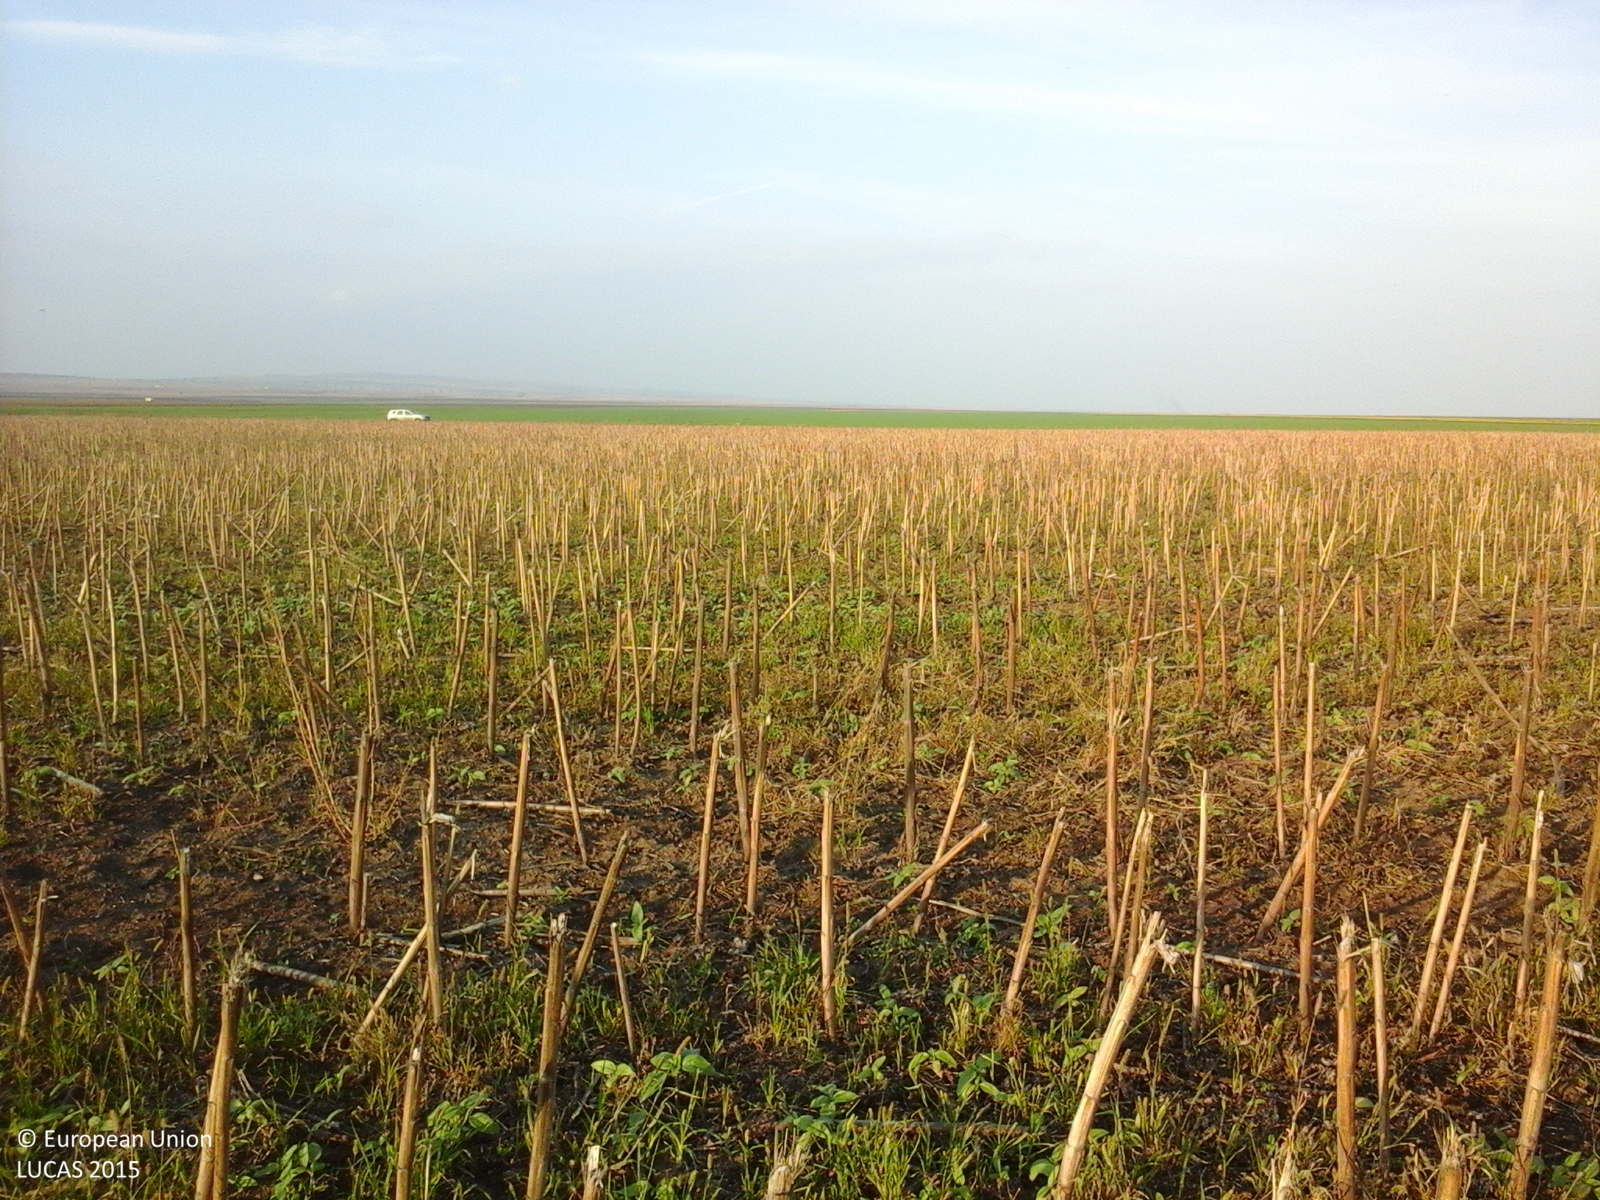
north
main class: Cropland
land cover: Sunflower
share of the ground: 25 - 50 %
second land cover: Spontaneously vegetated surfaces
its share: 25 - 50 %
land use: Agriculture (excluding fallow land and kitchen gardens)
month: October
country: RO
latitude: 45.2274
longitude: 26.9338
